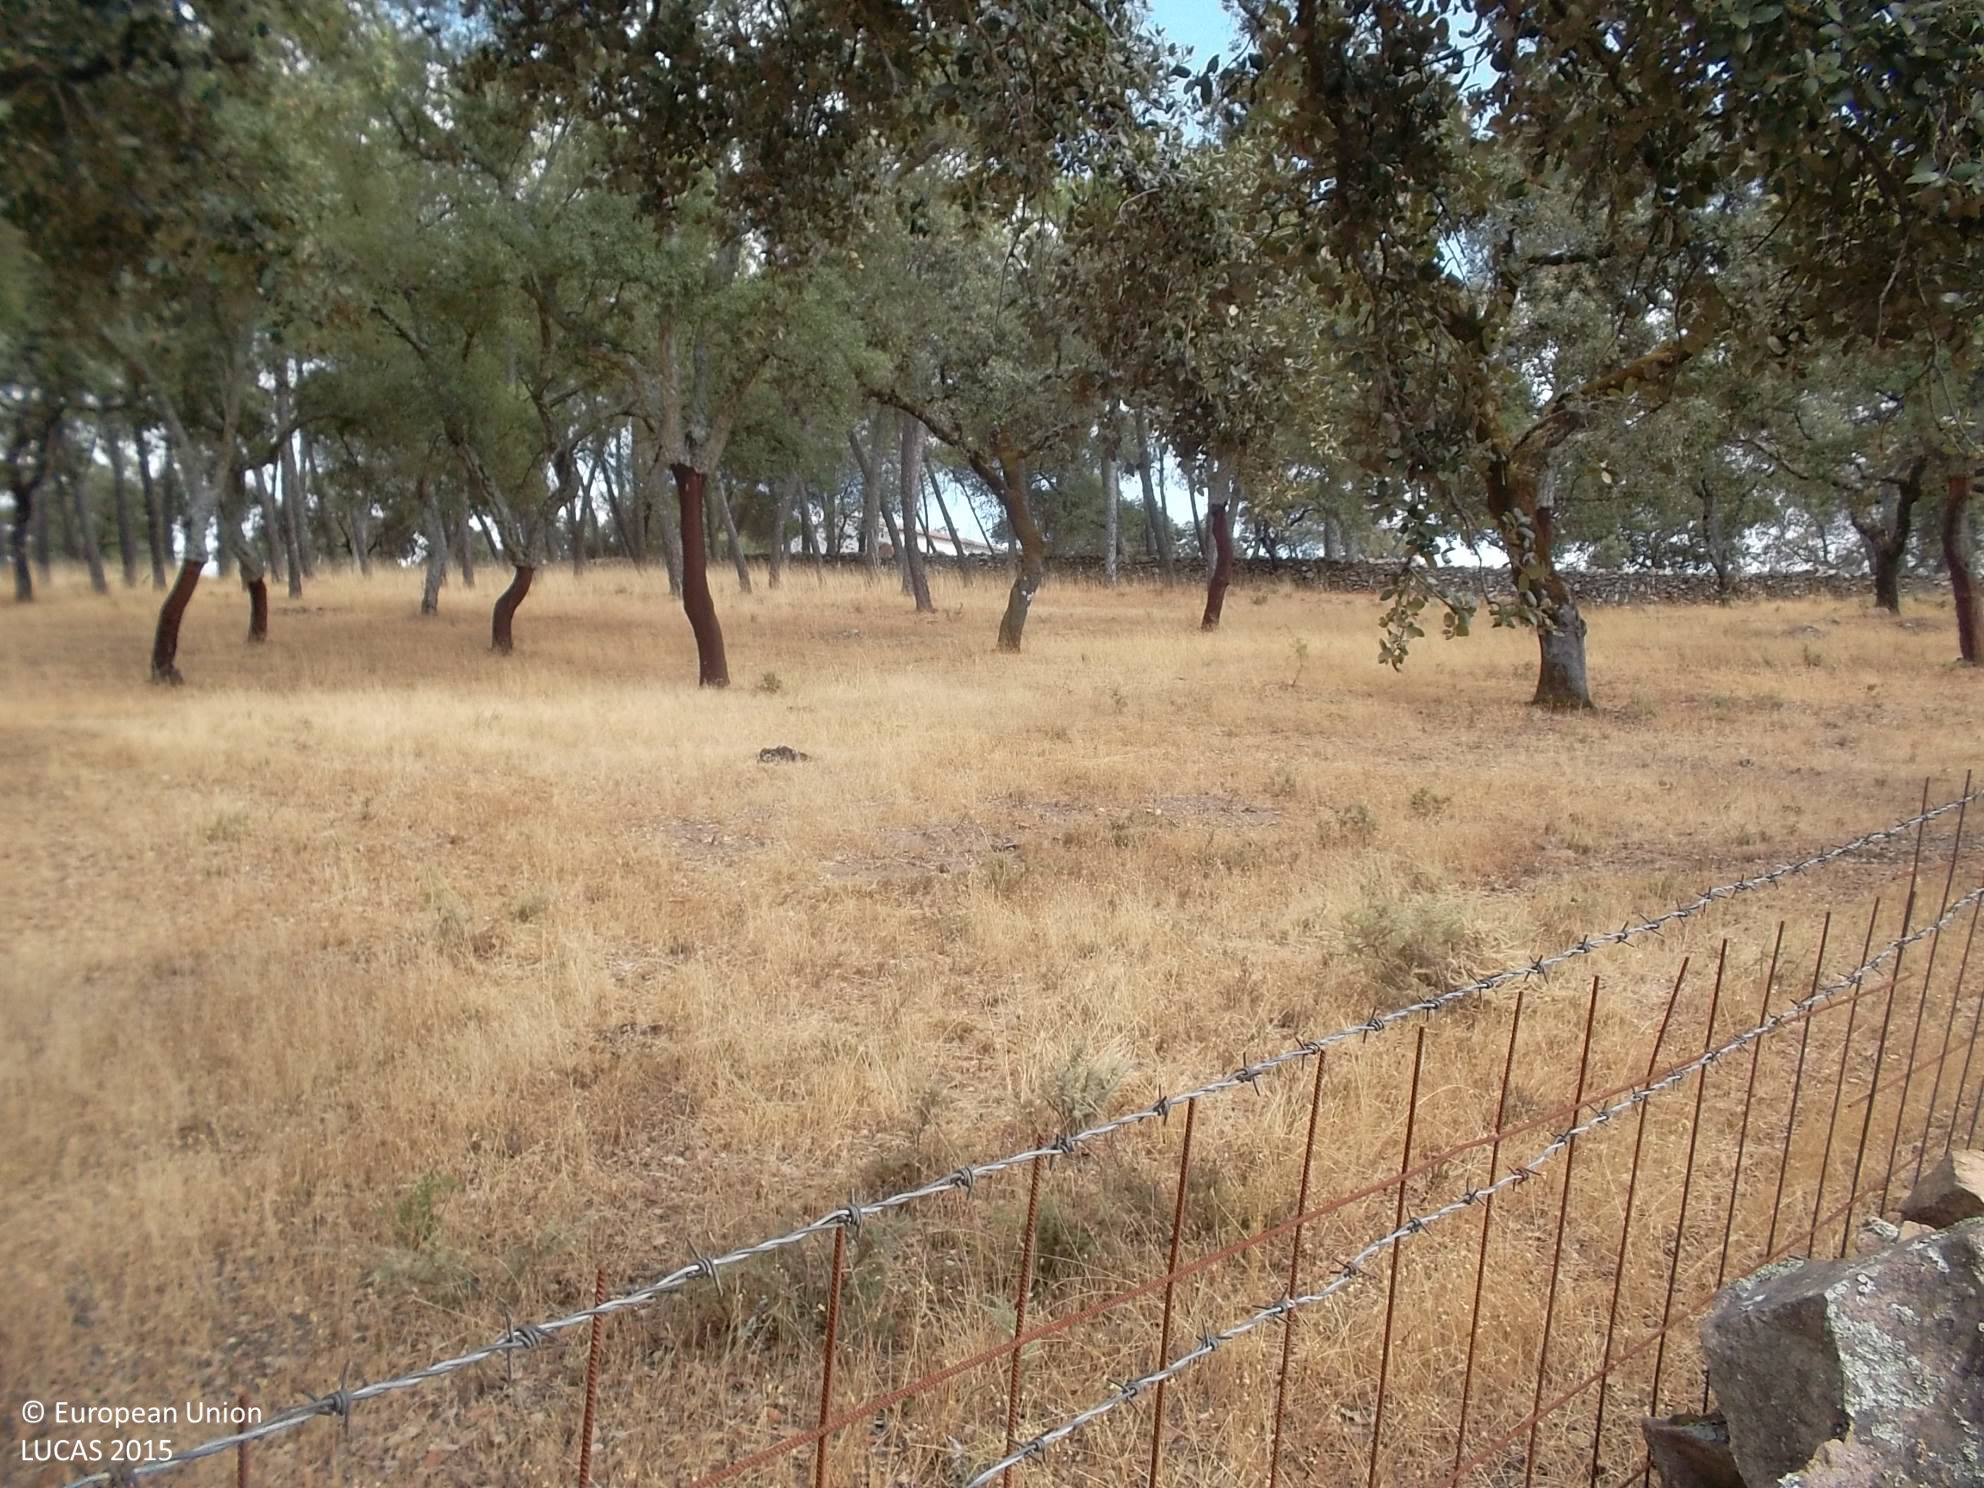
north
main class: Woodland
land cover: Broadleaved woodland
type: broadleaved evergreen forest
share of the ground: > 75 %
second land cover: Grassland without tree/shrub cover
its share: > 75 %
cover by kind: broadleaved forest trees 80 %, herbaceous plants 20 %
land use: Forestry
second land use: Agriculture (excluding fallow land and kitchen gardens)
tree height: > 5 m
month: September
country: ES
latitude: 38.0778
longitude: -6.5423
